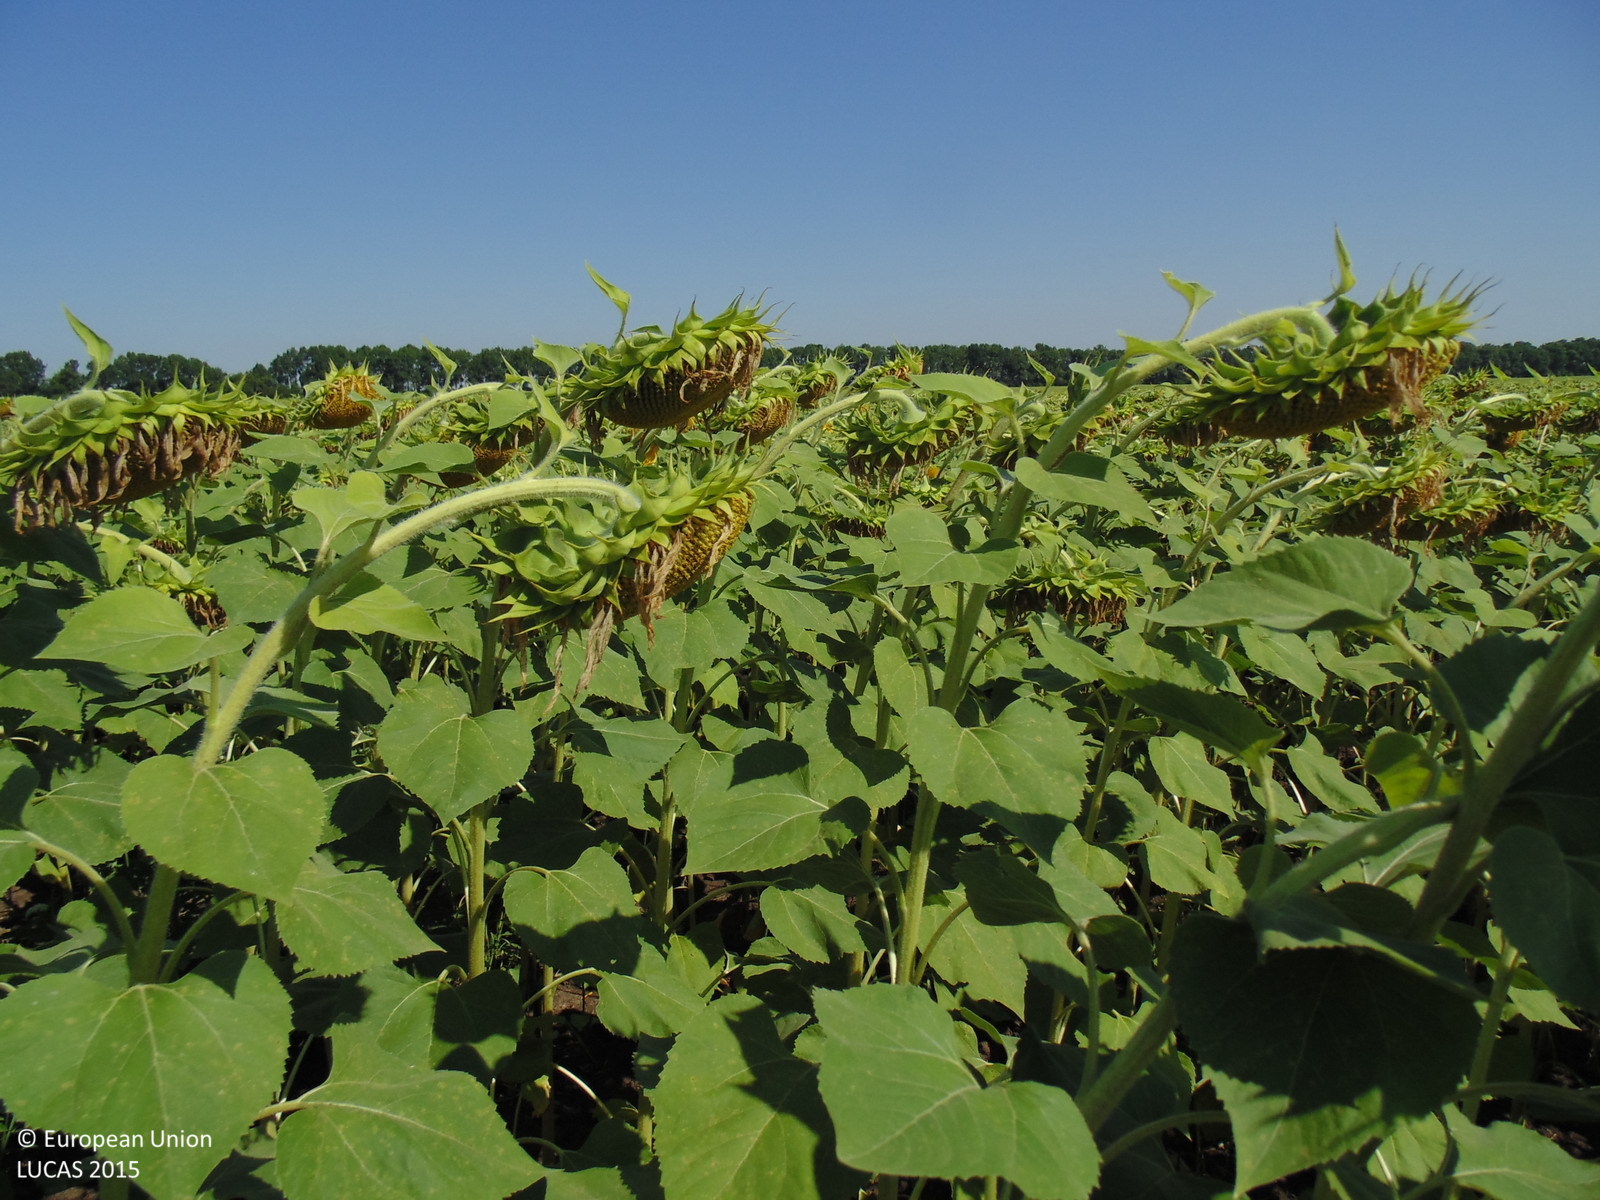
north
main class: Cropland
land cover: Sunflower
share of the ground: > 75 %
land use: Agriculture (excluding fallow land and kitchen gardens)
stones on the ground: < 10 %
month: August
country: BG
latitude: 43.5524
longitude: 28.1103
